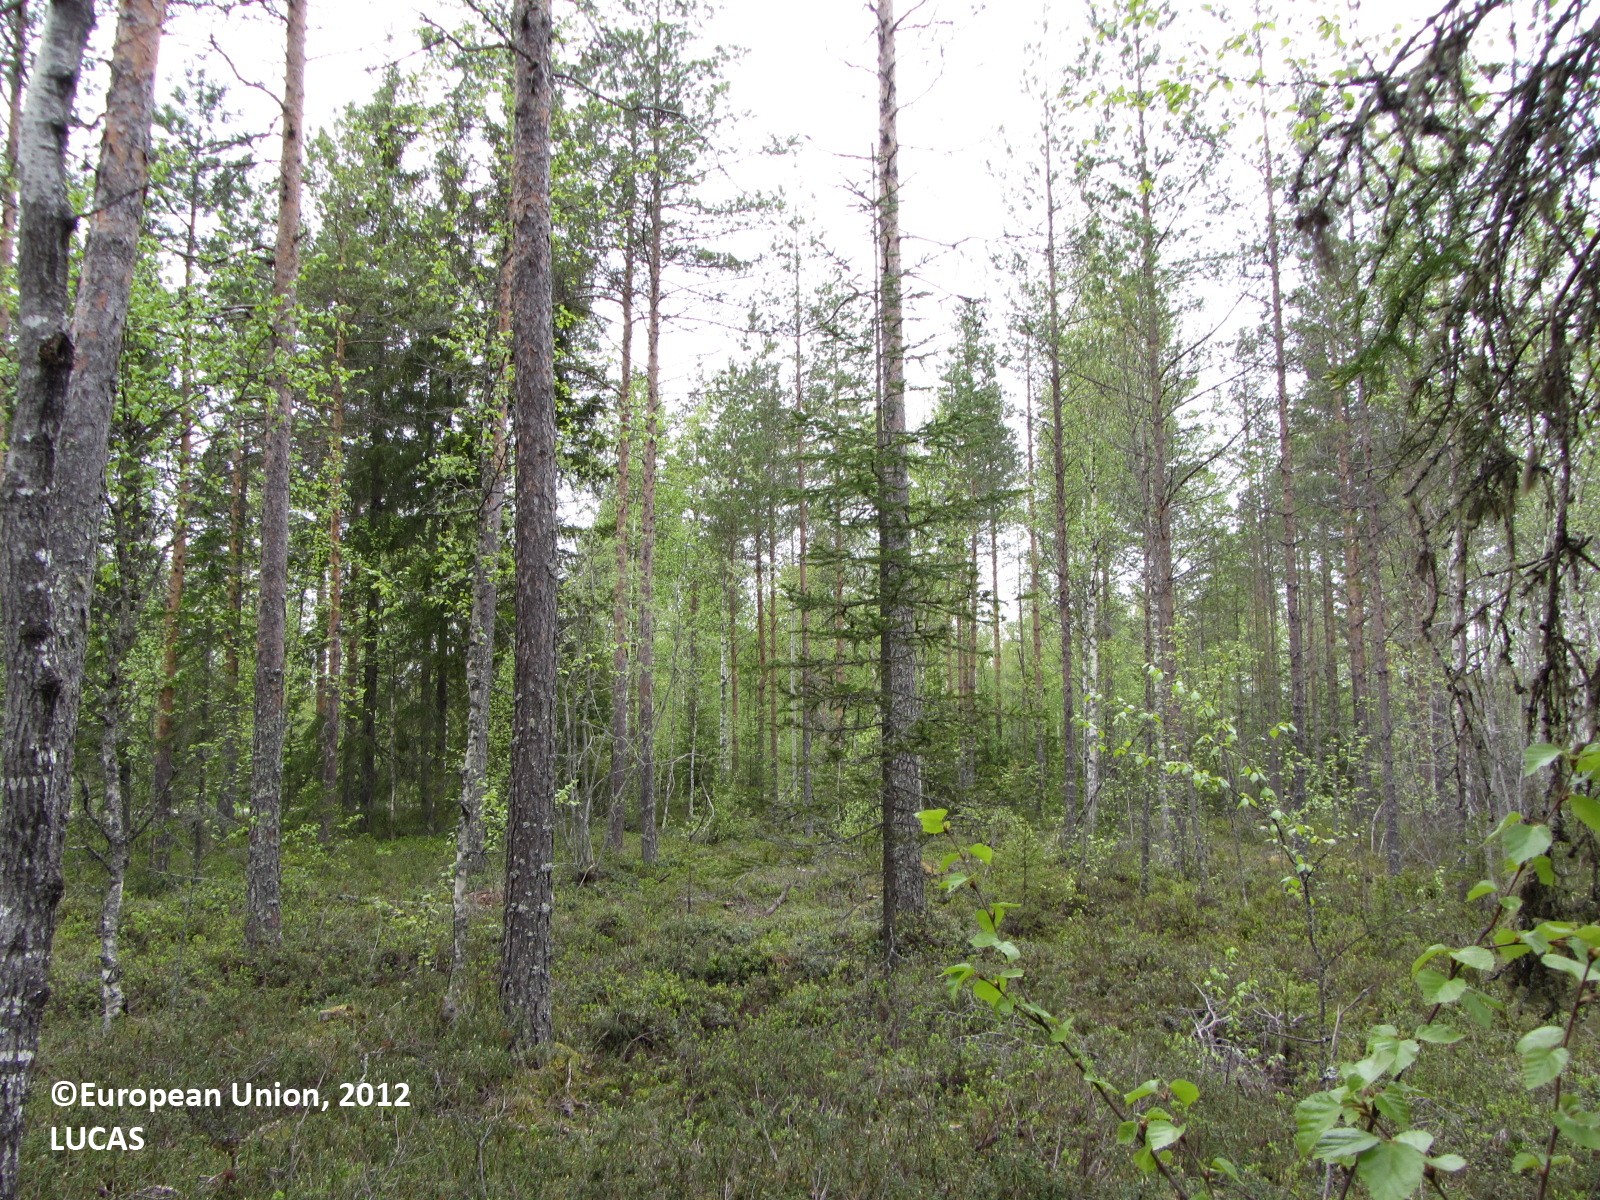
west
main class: Woodland
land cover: Pine dominated mixed woodland
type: boreal forest
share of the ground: > 75 %
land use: Forestry
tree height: > 5 m
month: June
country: FI
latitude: 63.8378
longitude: 24.6962
